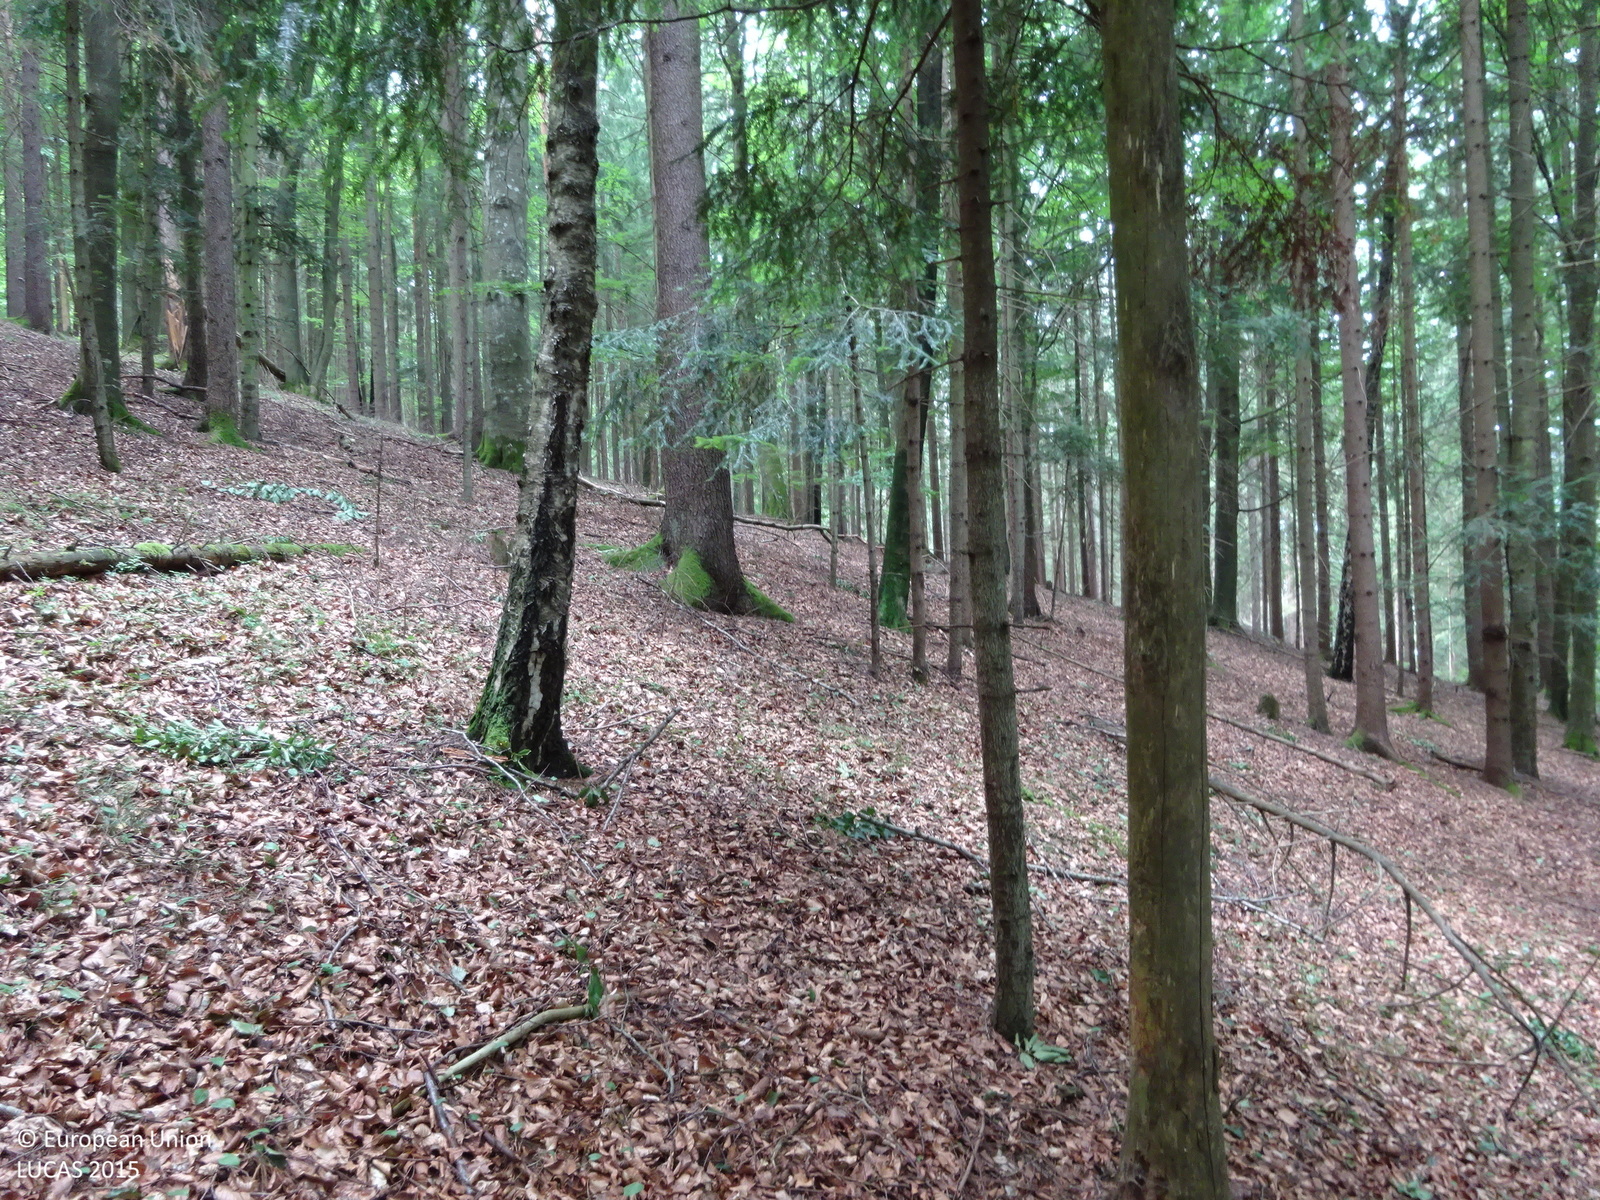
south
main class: Woodland
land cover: Spruce dominated mixed woodland
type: mountainous beech forest
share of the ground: > 75 %
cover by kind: coniferous forest trees 60 %, broadleaved forest trees 40 %
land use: Forestry
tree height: > 5 m
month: July
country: AT
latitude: 47.2573
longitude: 15.4844
